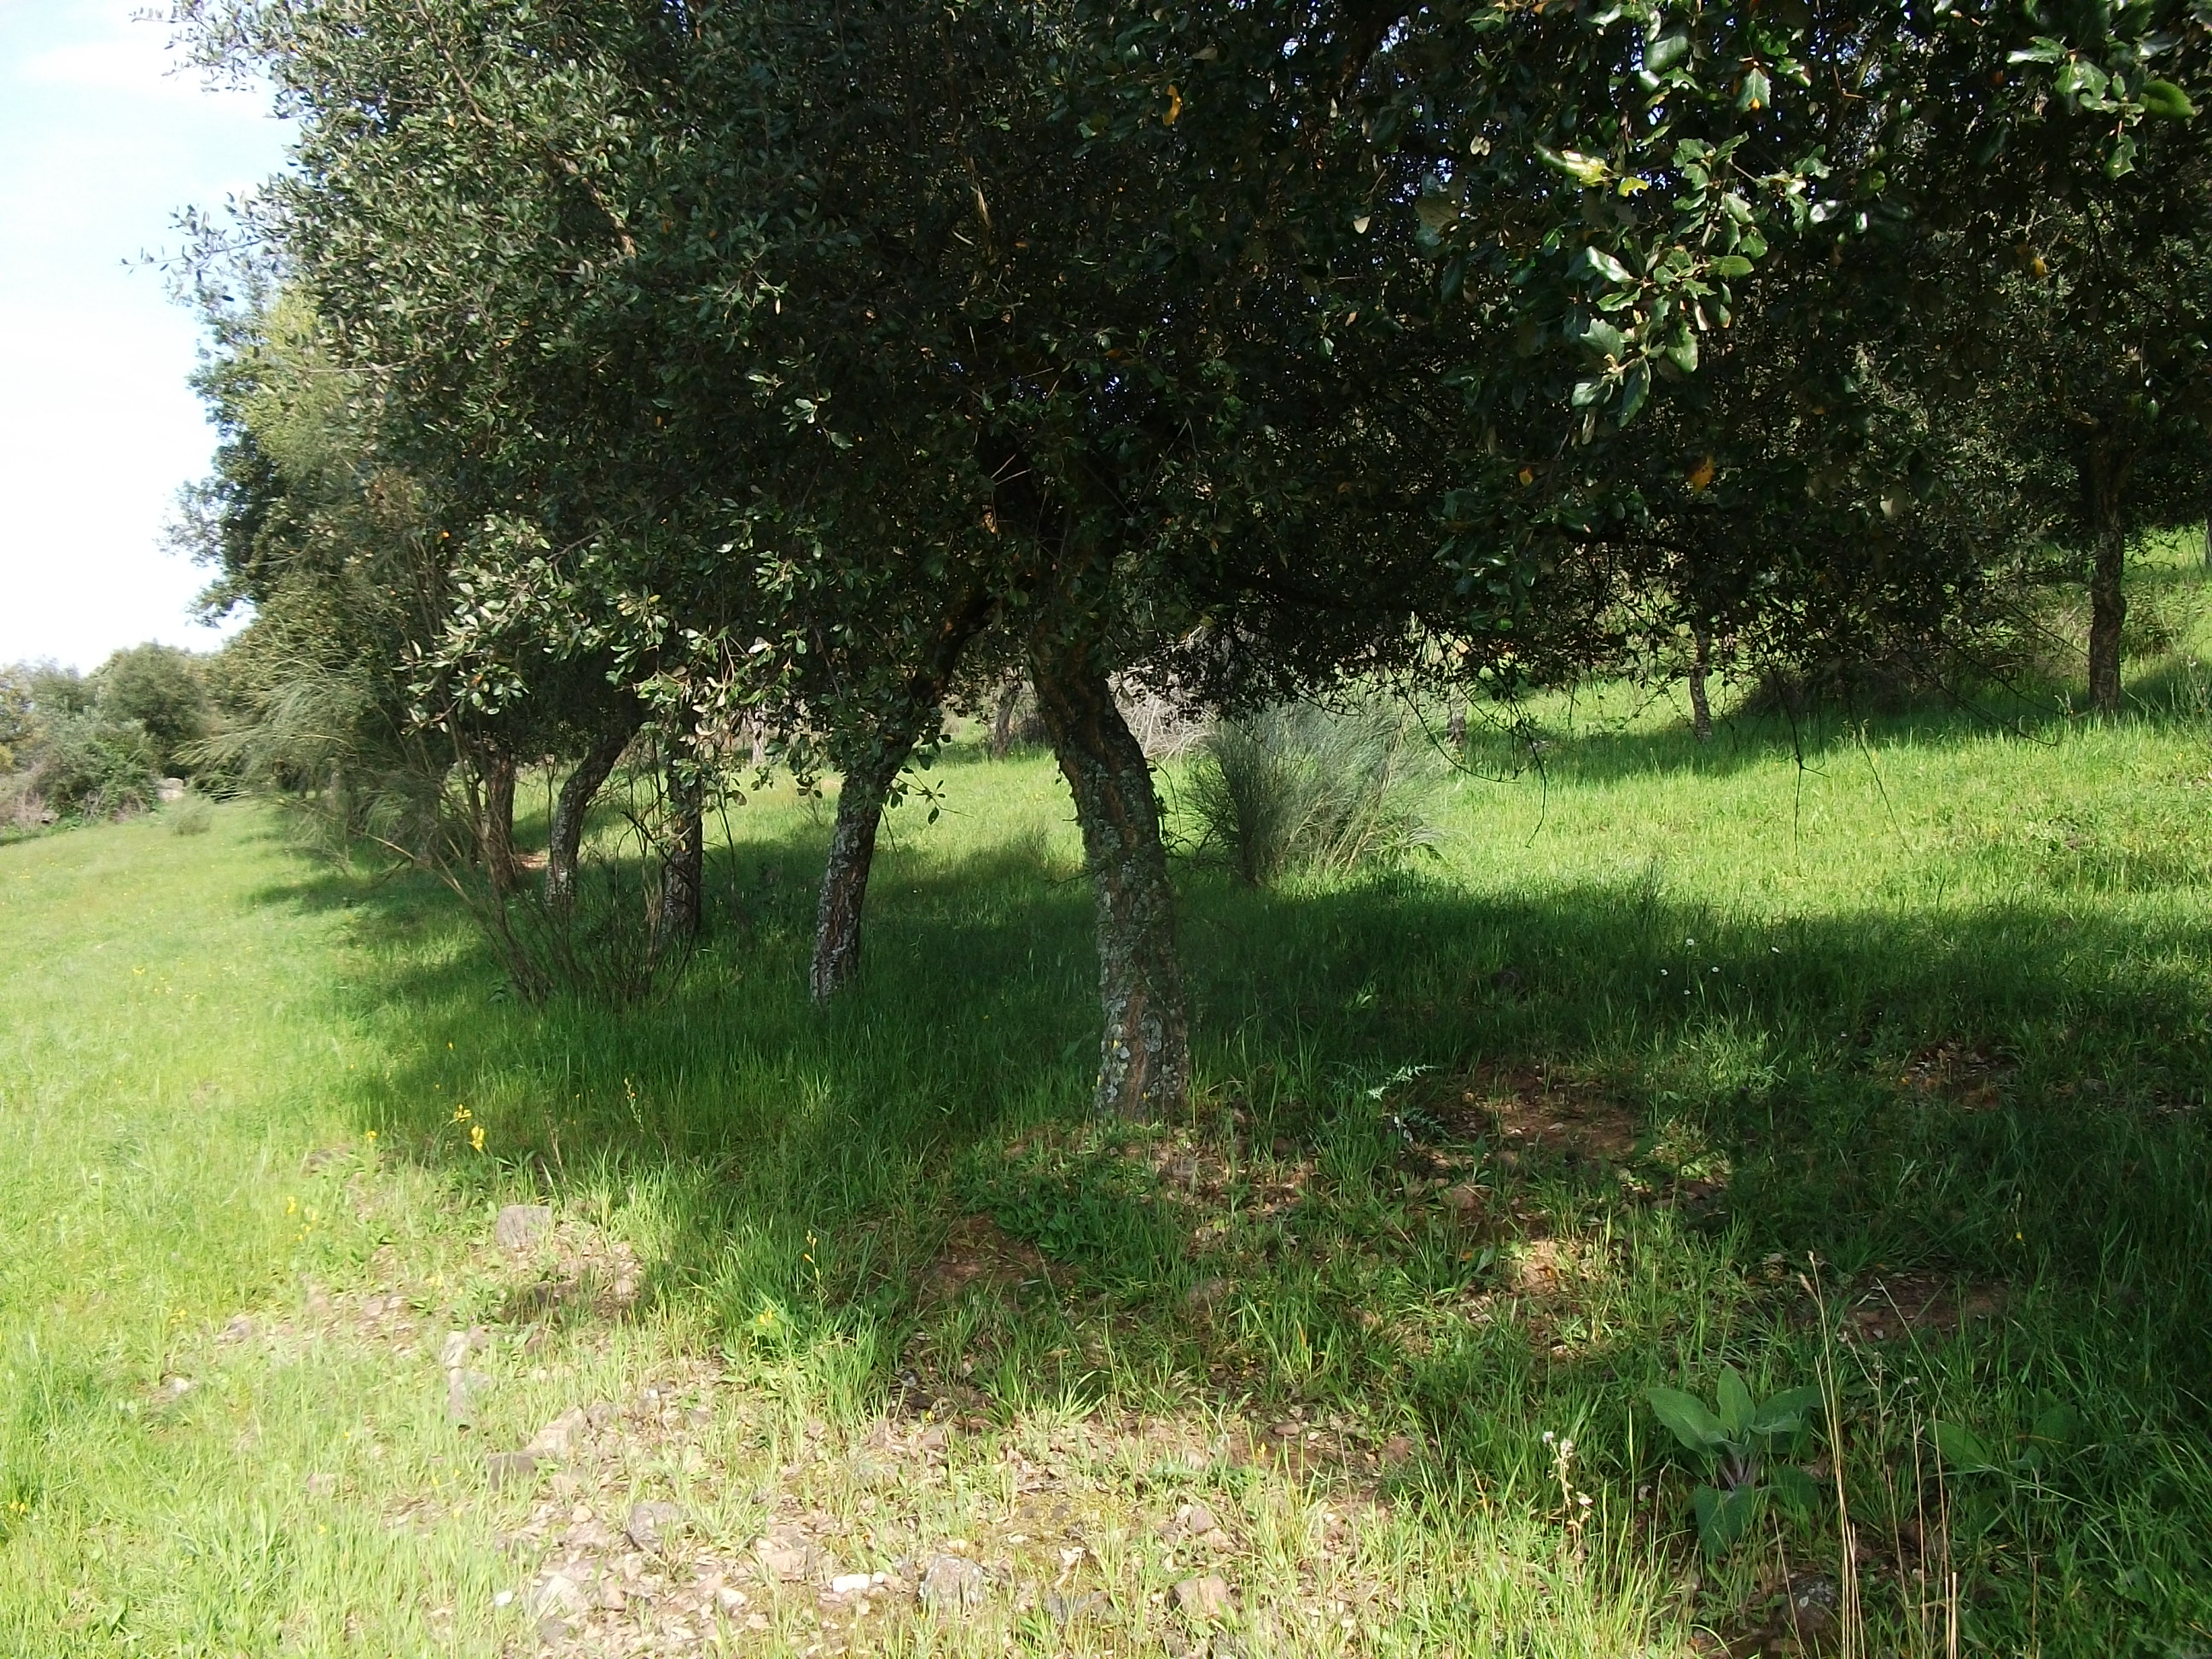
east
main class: Woodland
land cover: Broadleaved woodland
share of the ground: 50 - 75 %
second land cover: Olive groves
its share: 10 - 25 %
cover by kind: broadleaved forest trees 70 %, herbaceous plants 10 %
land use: Forestry
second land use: Agriculture (excluding fallow land and kitchen gardens)
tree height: < 5 m
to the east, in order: Broadleaved woodland; Olive groves; Dry stone walls; Broadleaved woodland; Dry stone walls; Broadleaved woodland
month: April
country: ES
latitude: 38.0817
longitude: -6.7293
